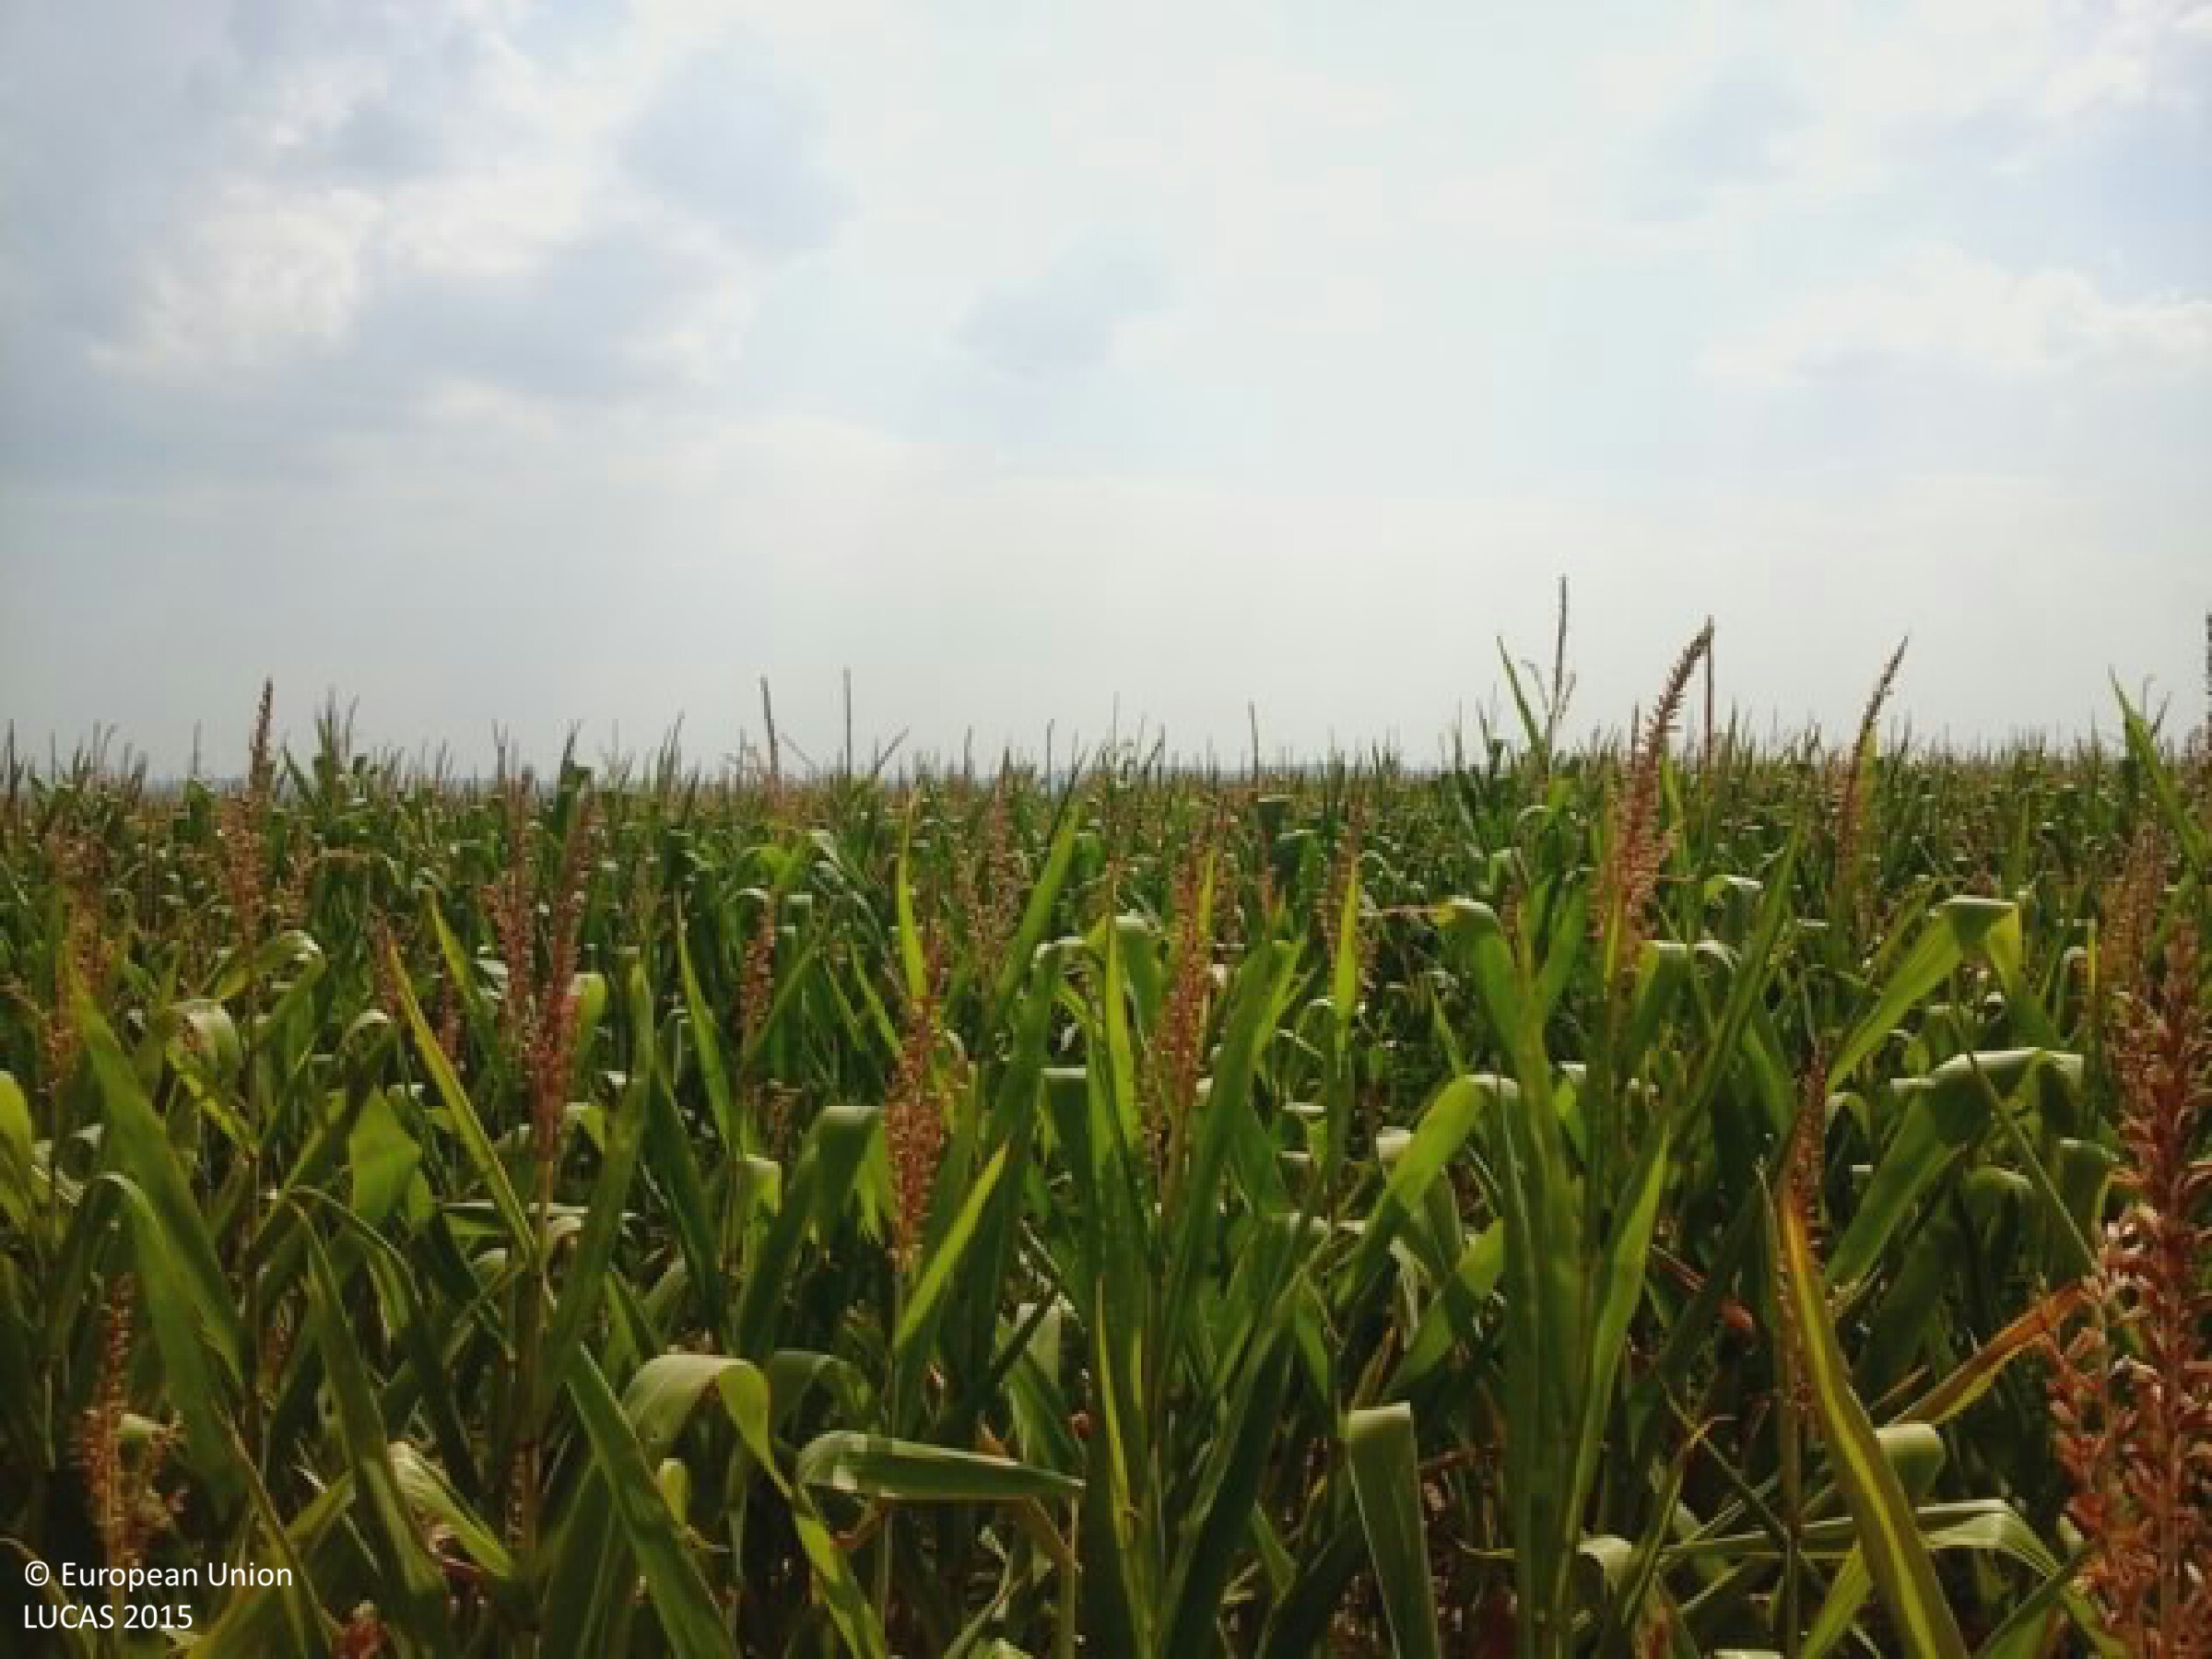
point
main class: Cropland
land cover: Maize
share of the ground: > 75 %
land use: Agriculture (excluding fallow land and kitchen gardens)
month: August
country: HU
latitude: 46.3571
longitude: 18.2610
